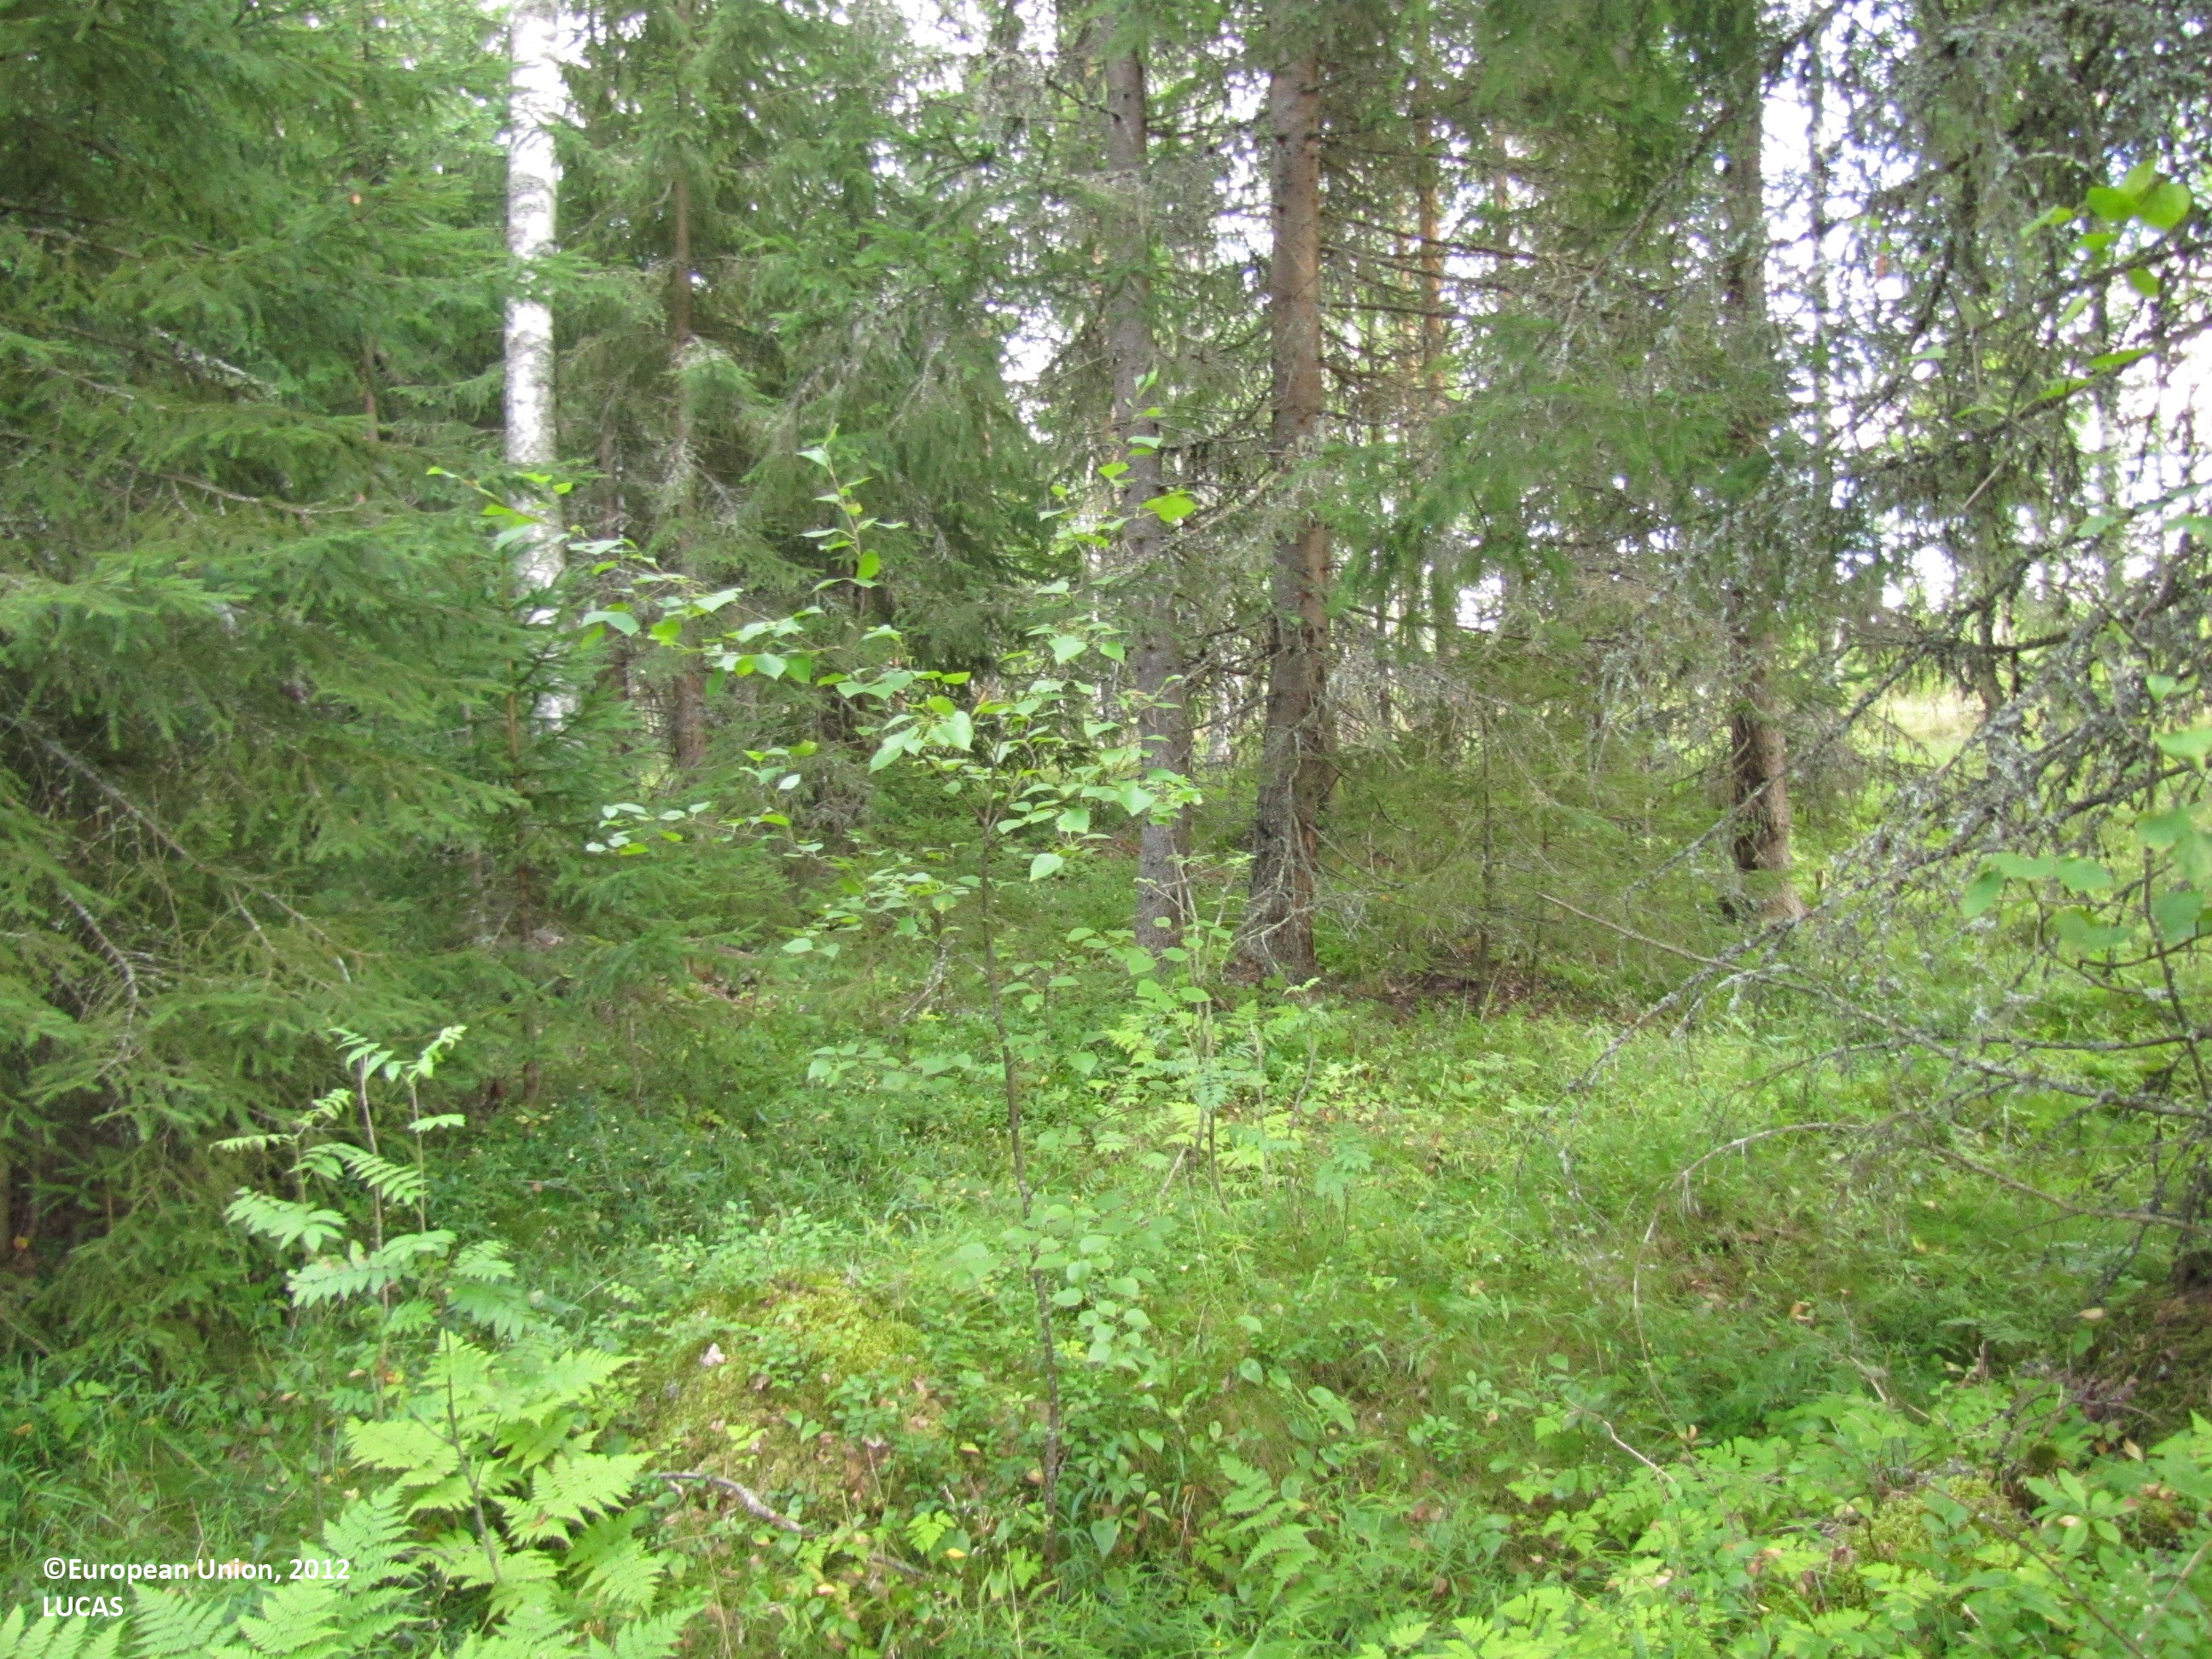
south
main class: Woodland
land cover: Spruce dominated mixed woodland
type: boreal forest
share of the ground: 50 - 75 %
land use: Forestry
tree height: > 5 m
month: August
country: FI
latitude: 61.7104
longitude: 23.0647
